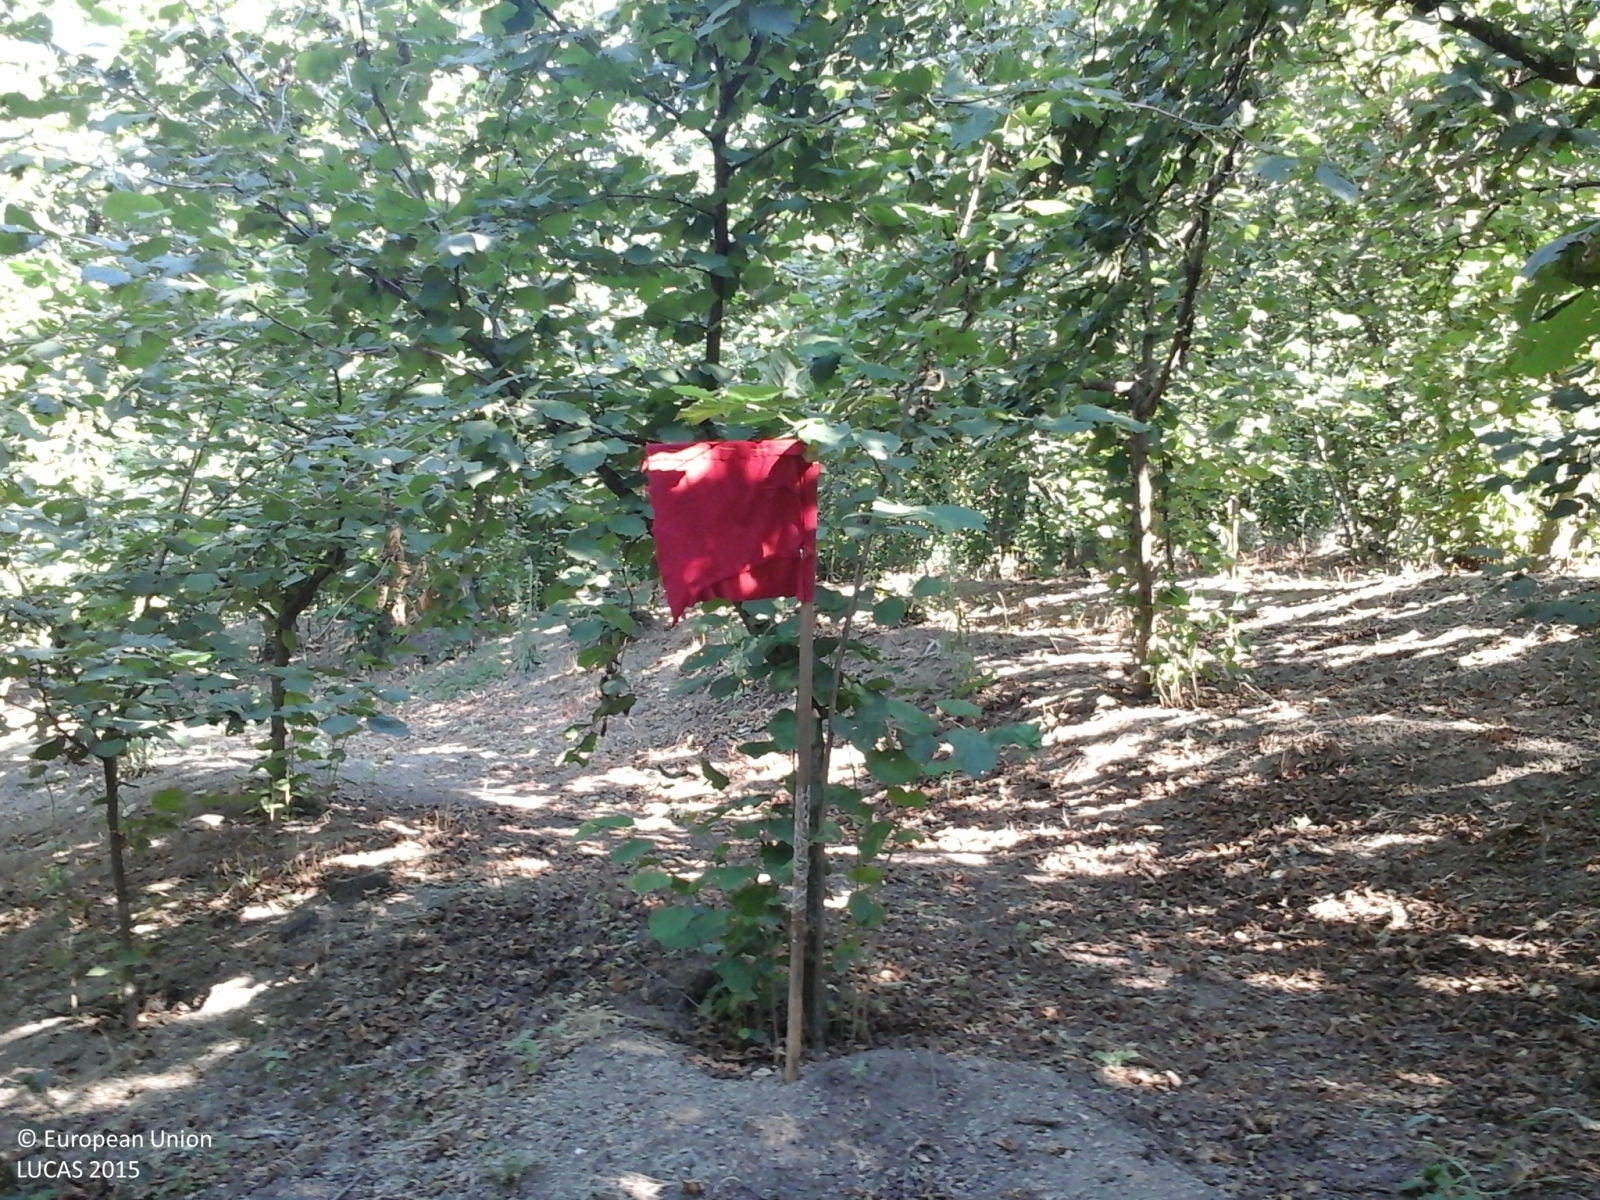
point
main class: Cropland
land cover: Nuts trees
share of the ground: > 75 %
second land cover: Other bare soil
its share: > 75 %
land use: Agriculture (excluding fallow land and kitchen gardens)
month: July
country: IT
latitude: 40.8822
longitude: 14.6451
